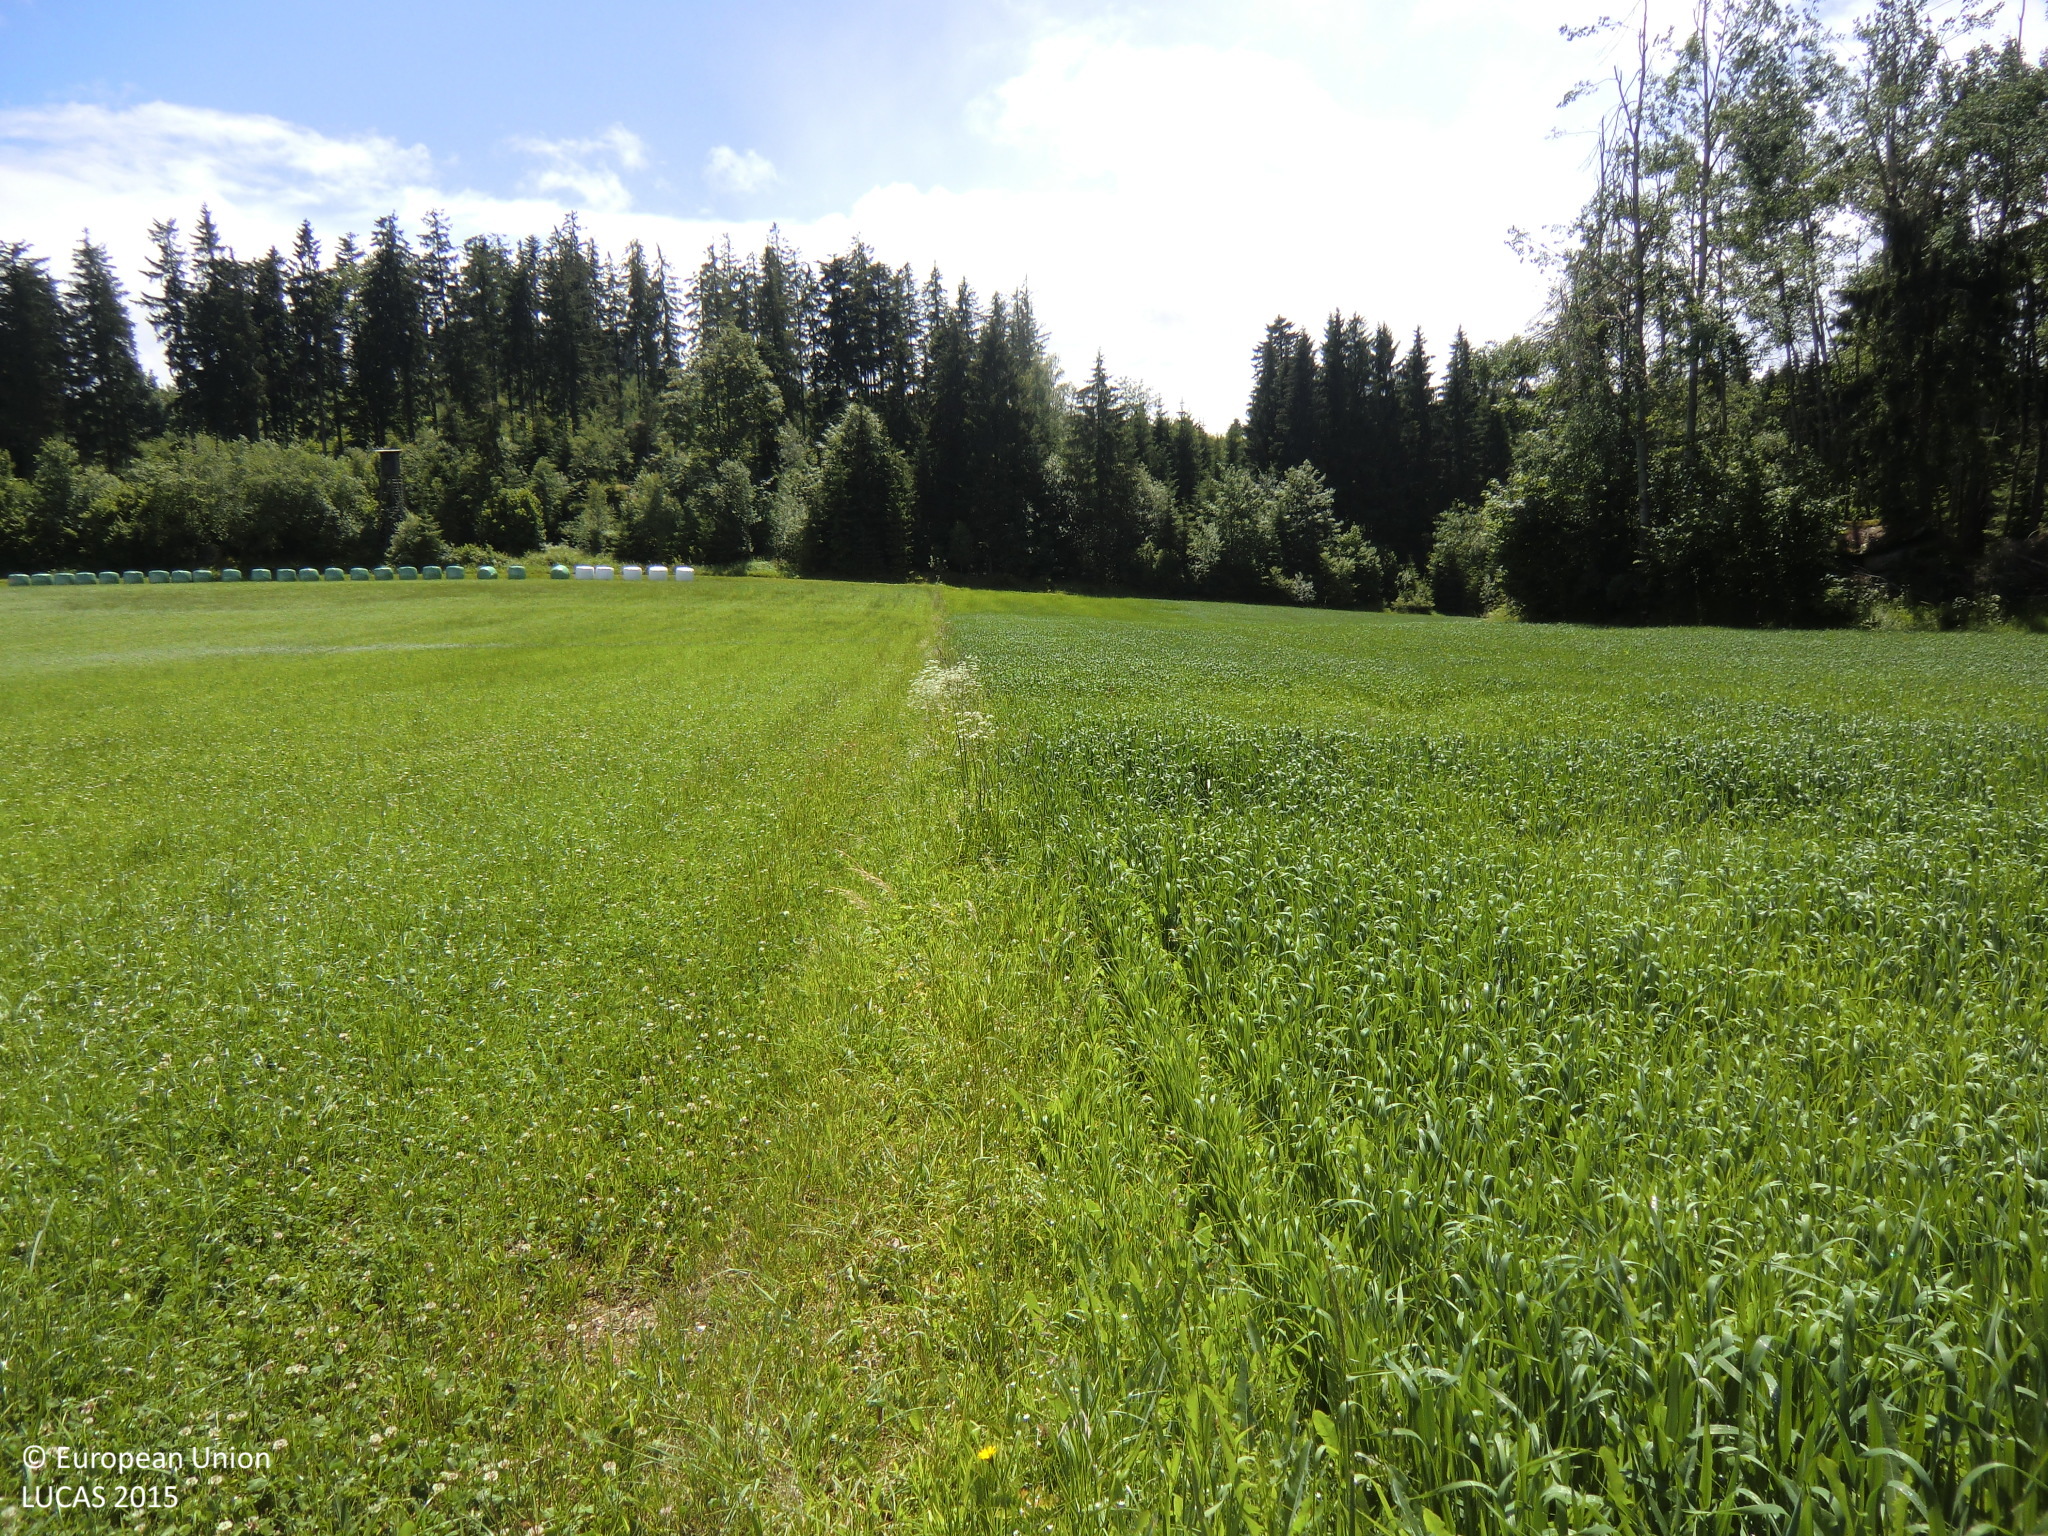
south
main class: Cropland
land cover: Rye
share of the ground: > 75 %
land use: Agriculture (excluding fallow land and kitchen gardens)
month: June
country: AT
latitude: 48.4315
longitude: 15.0700
